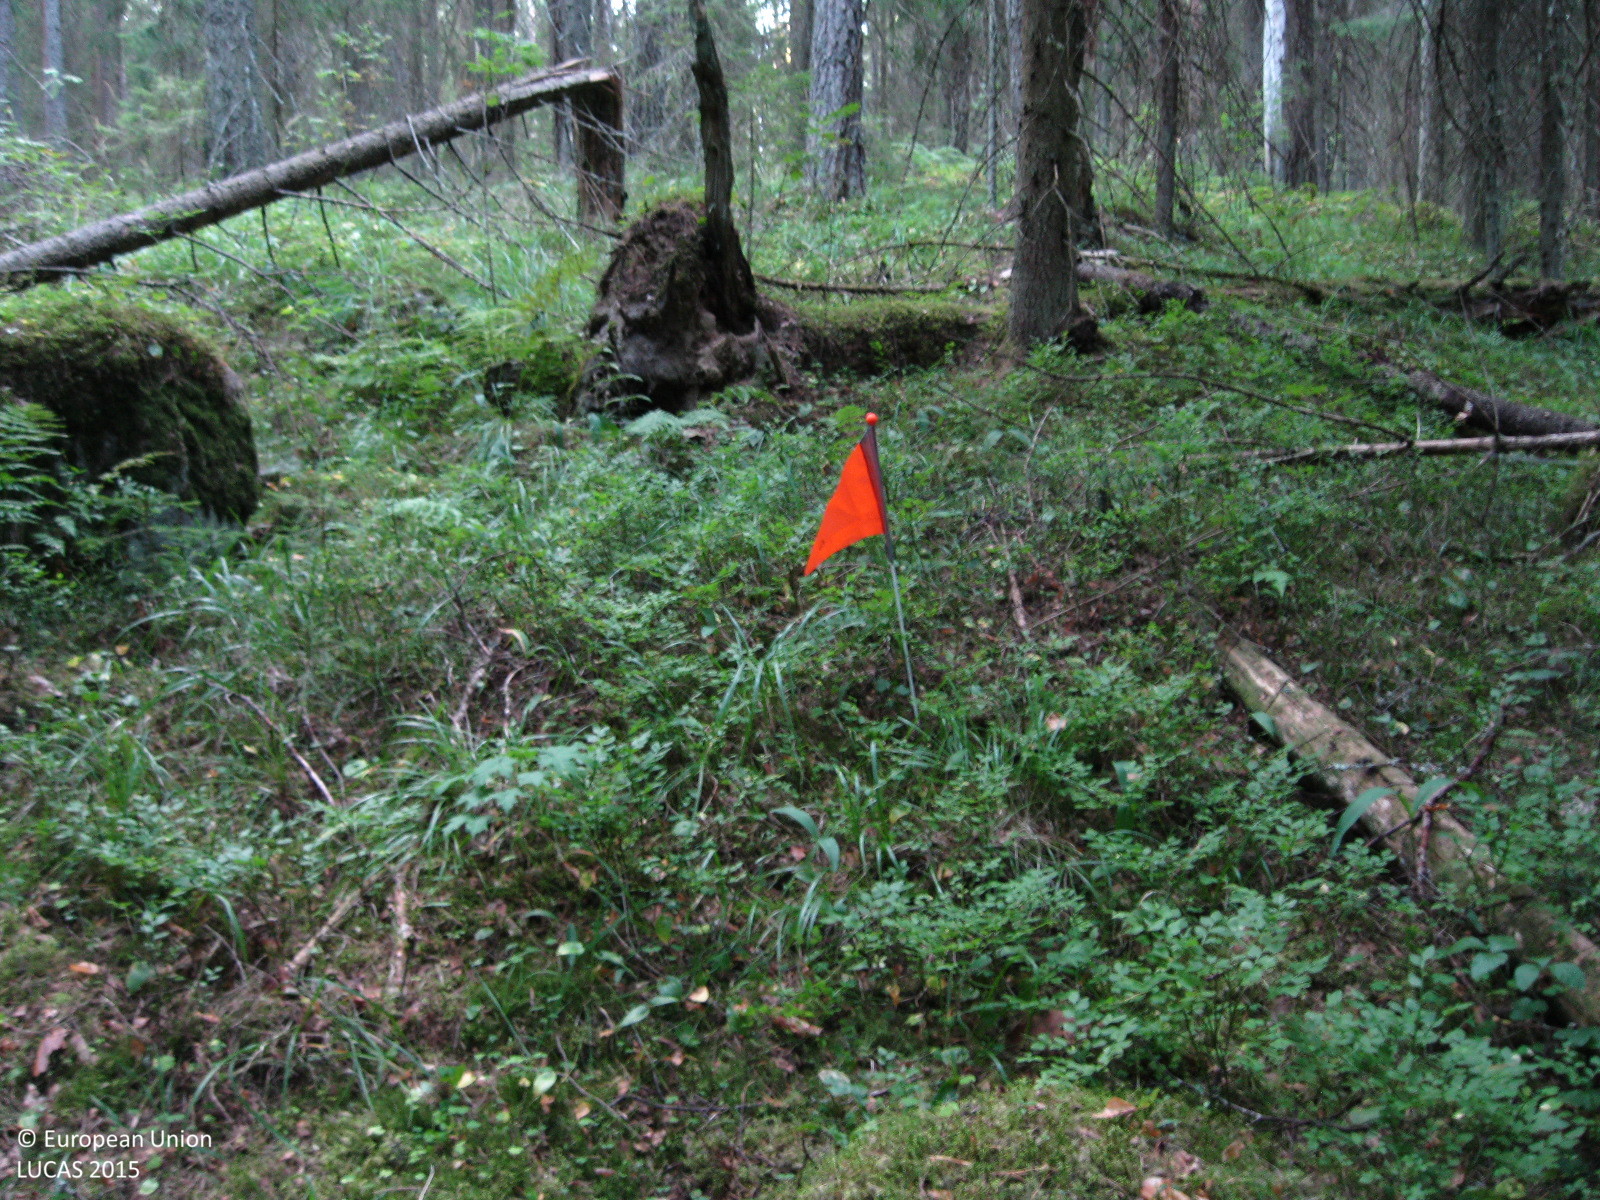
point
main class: Woodland
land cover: Other coniferous woodland
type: boreal forest
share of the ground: > 75 %
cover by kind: coniferous forest trees 85 %, herbaceous plants 10 %, broadleaved forest trees 5 %
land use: Forestry
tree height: > 5 m
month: August
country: FI
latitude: 61.3057
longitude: 25.1440
